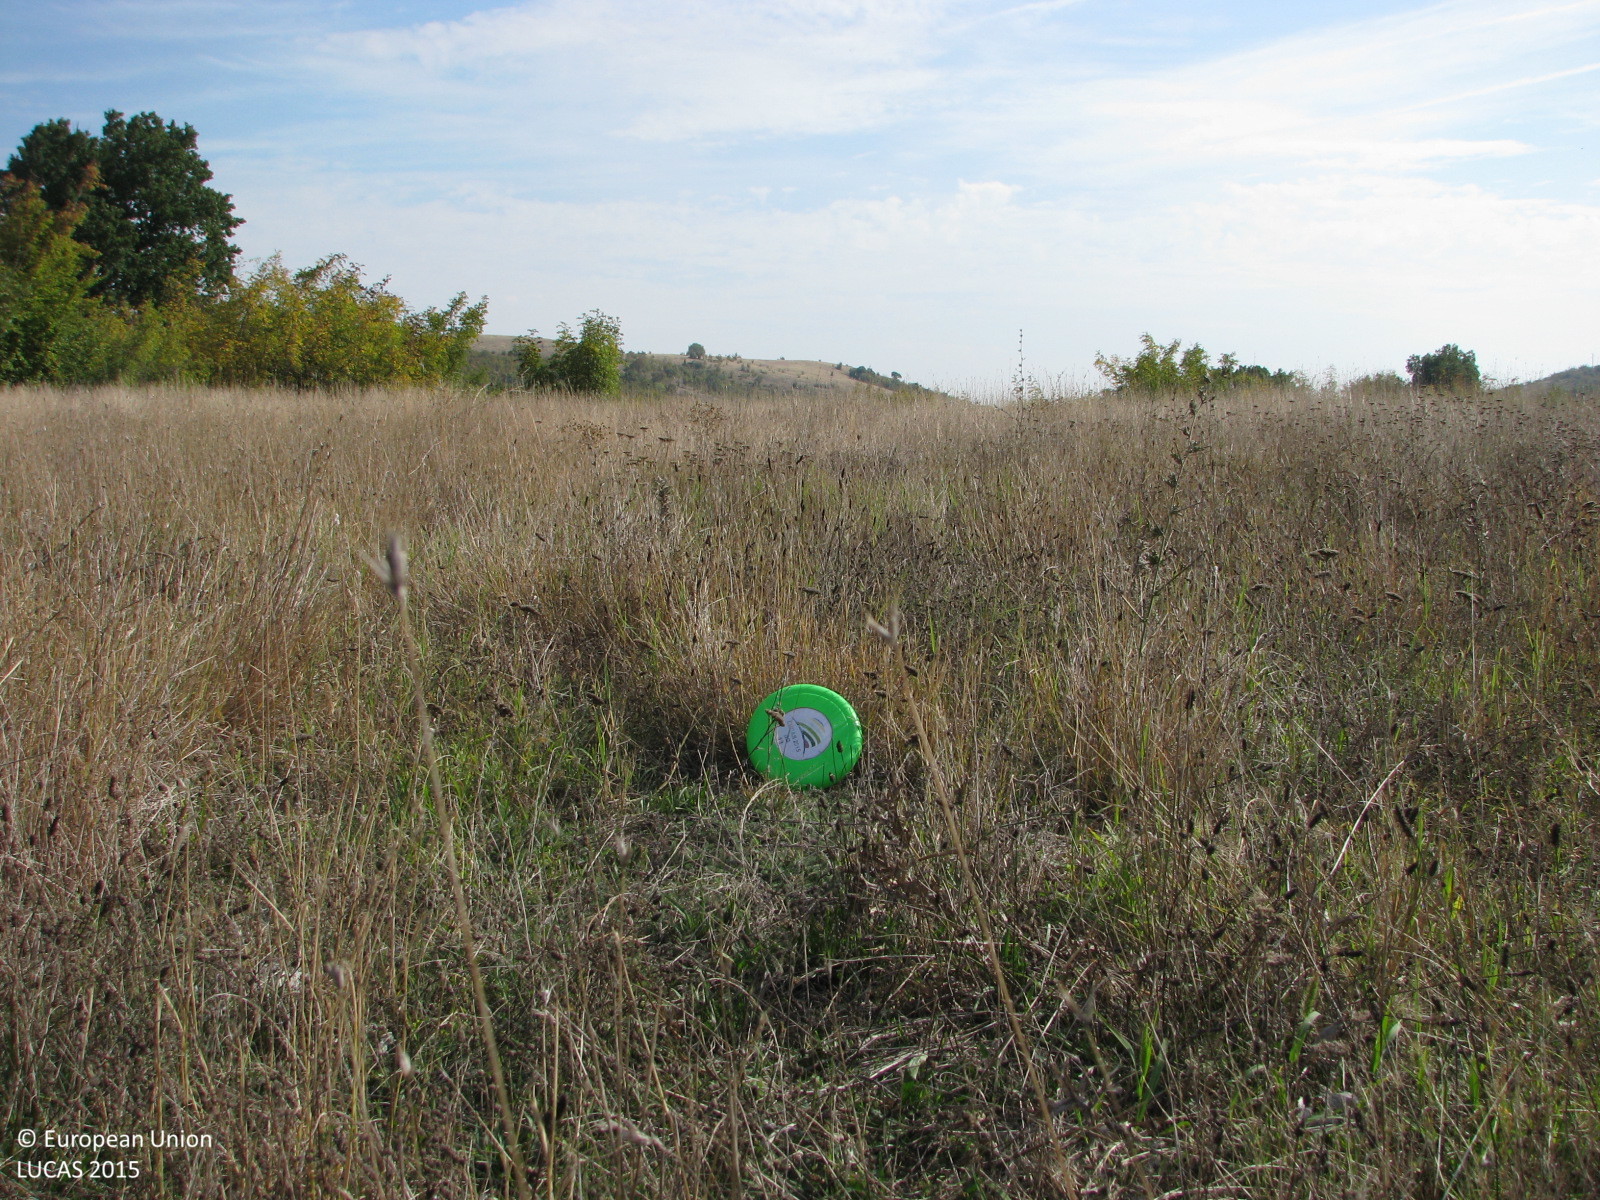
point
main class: Grassland
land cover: Grassland without tree/shrub cover
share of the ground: > 75 %
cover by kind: herbaceous plants 100 %
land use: Agriculture (excluding fallow land and kitchen gardens)
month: October
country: BG
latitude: 42.5287
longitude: 25.8930
